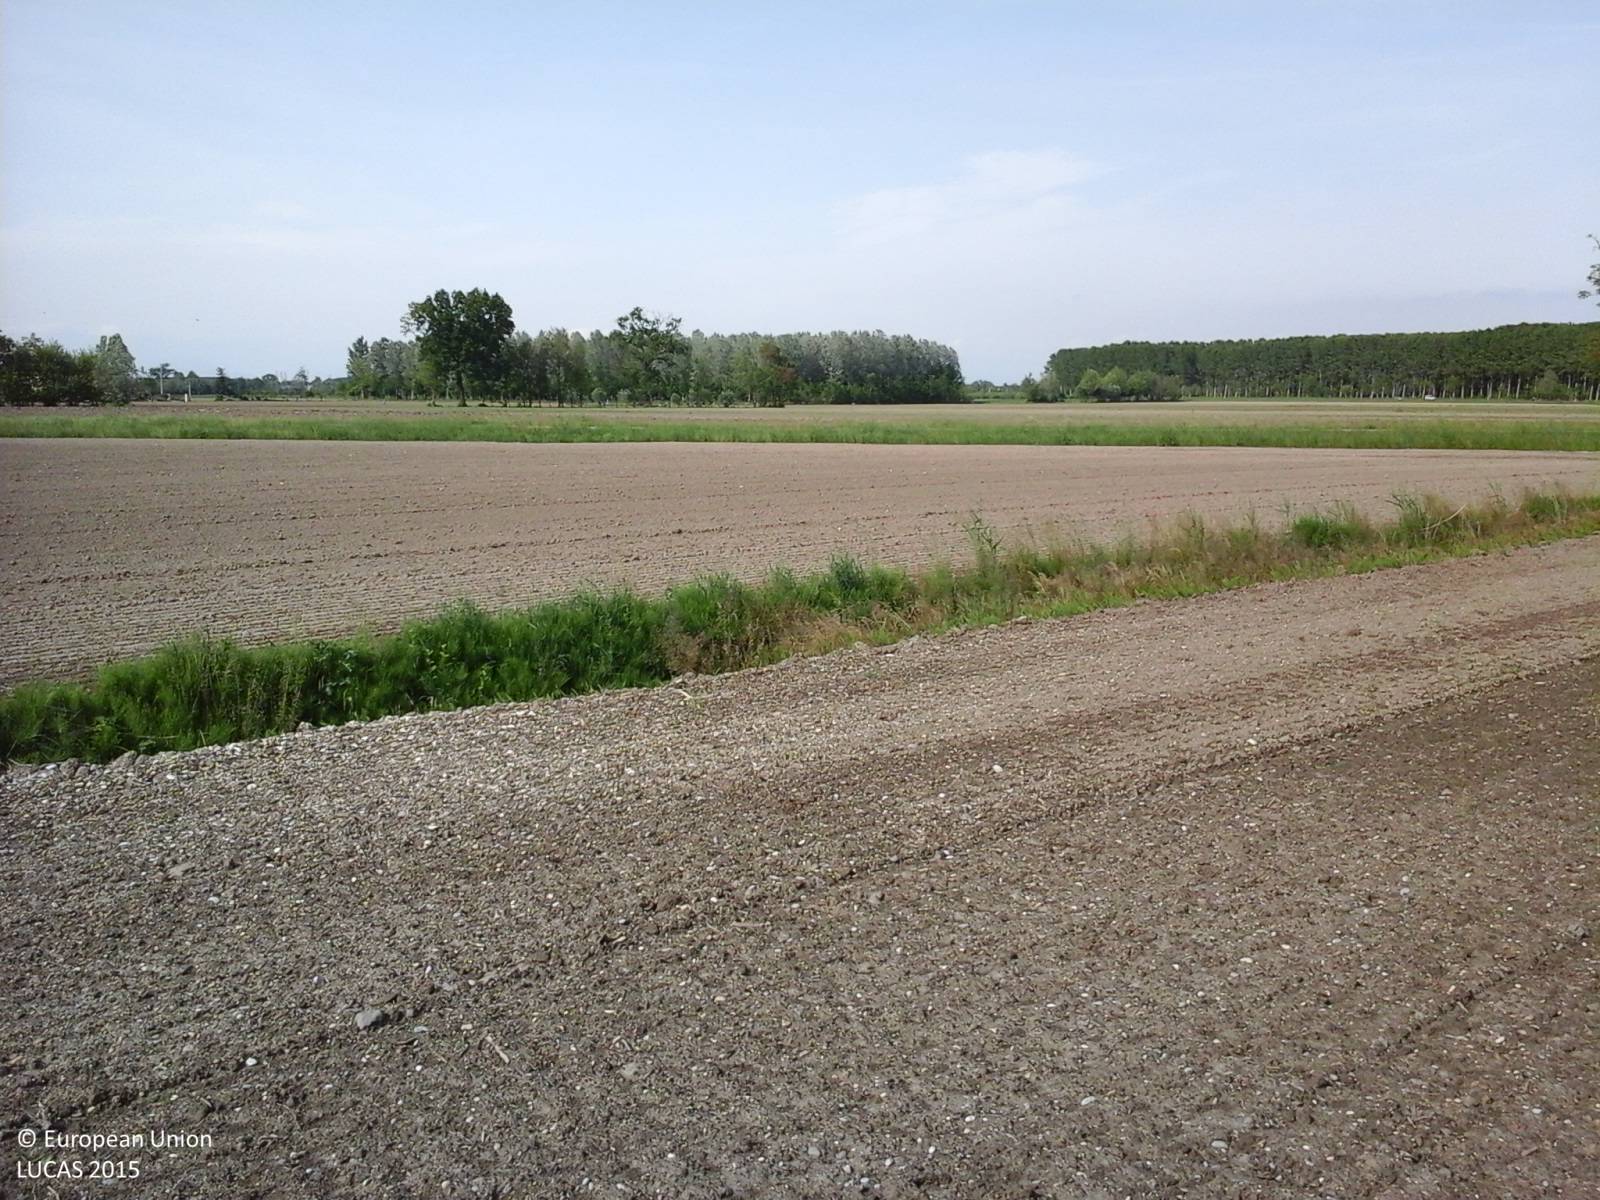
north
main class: Cropland
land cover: Soya
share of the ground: < 10 %
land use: Agriculture (excluding fallow land and kitchen gardens)
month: May
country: IT
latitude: 45.8578
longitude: 13.0229
